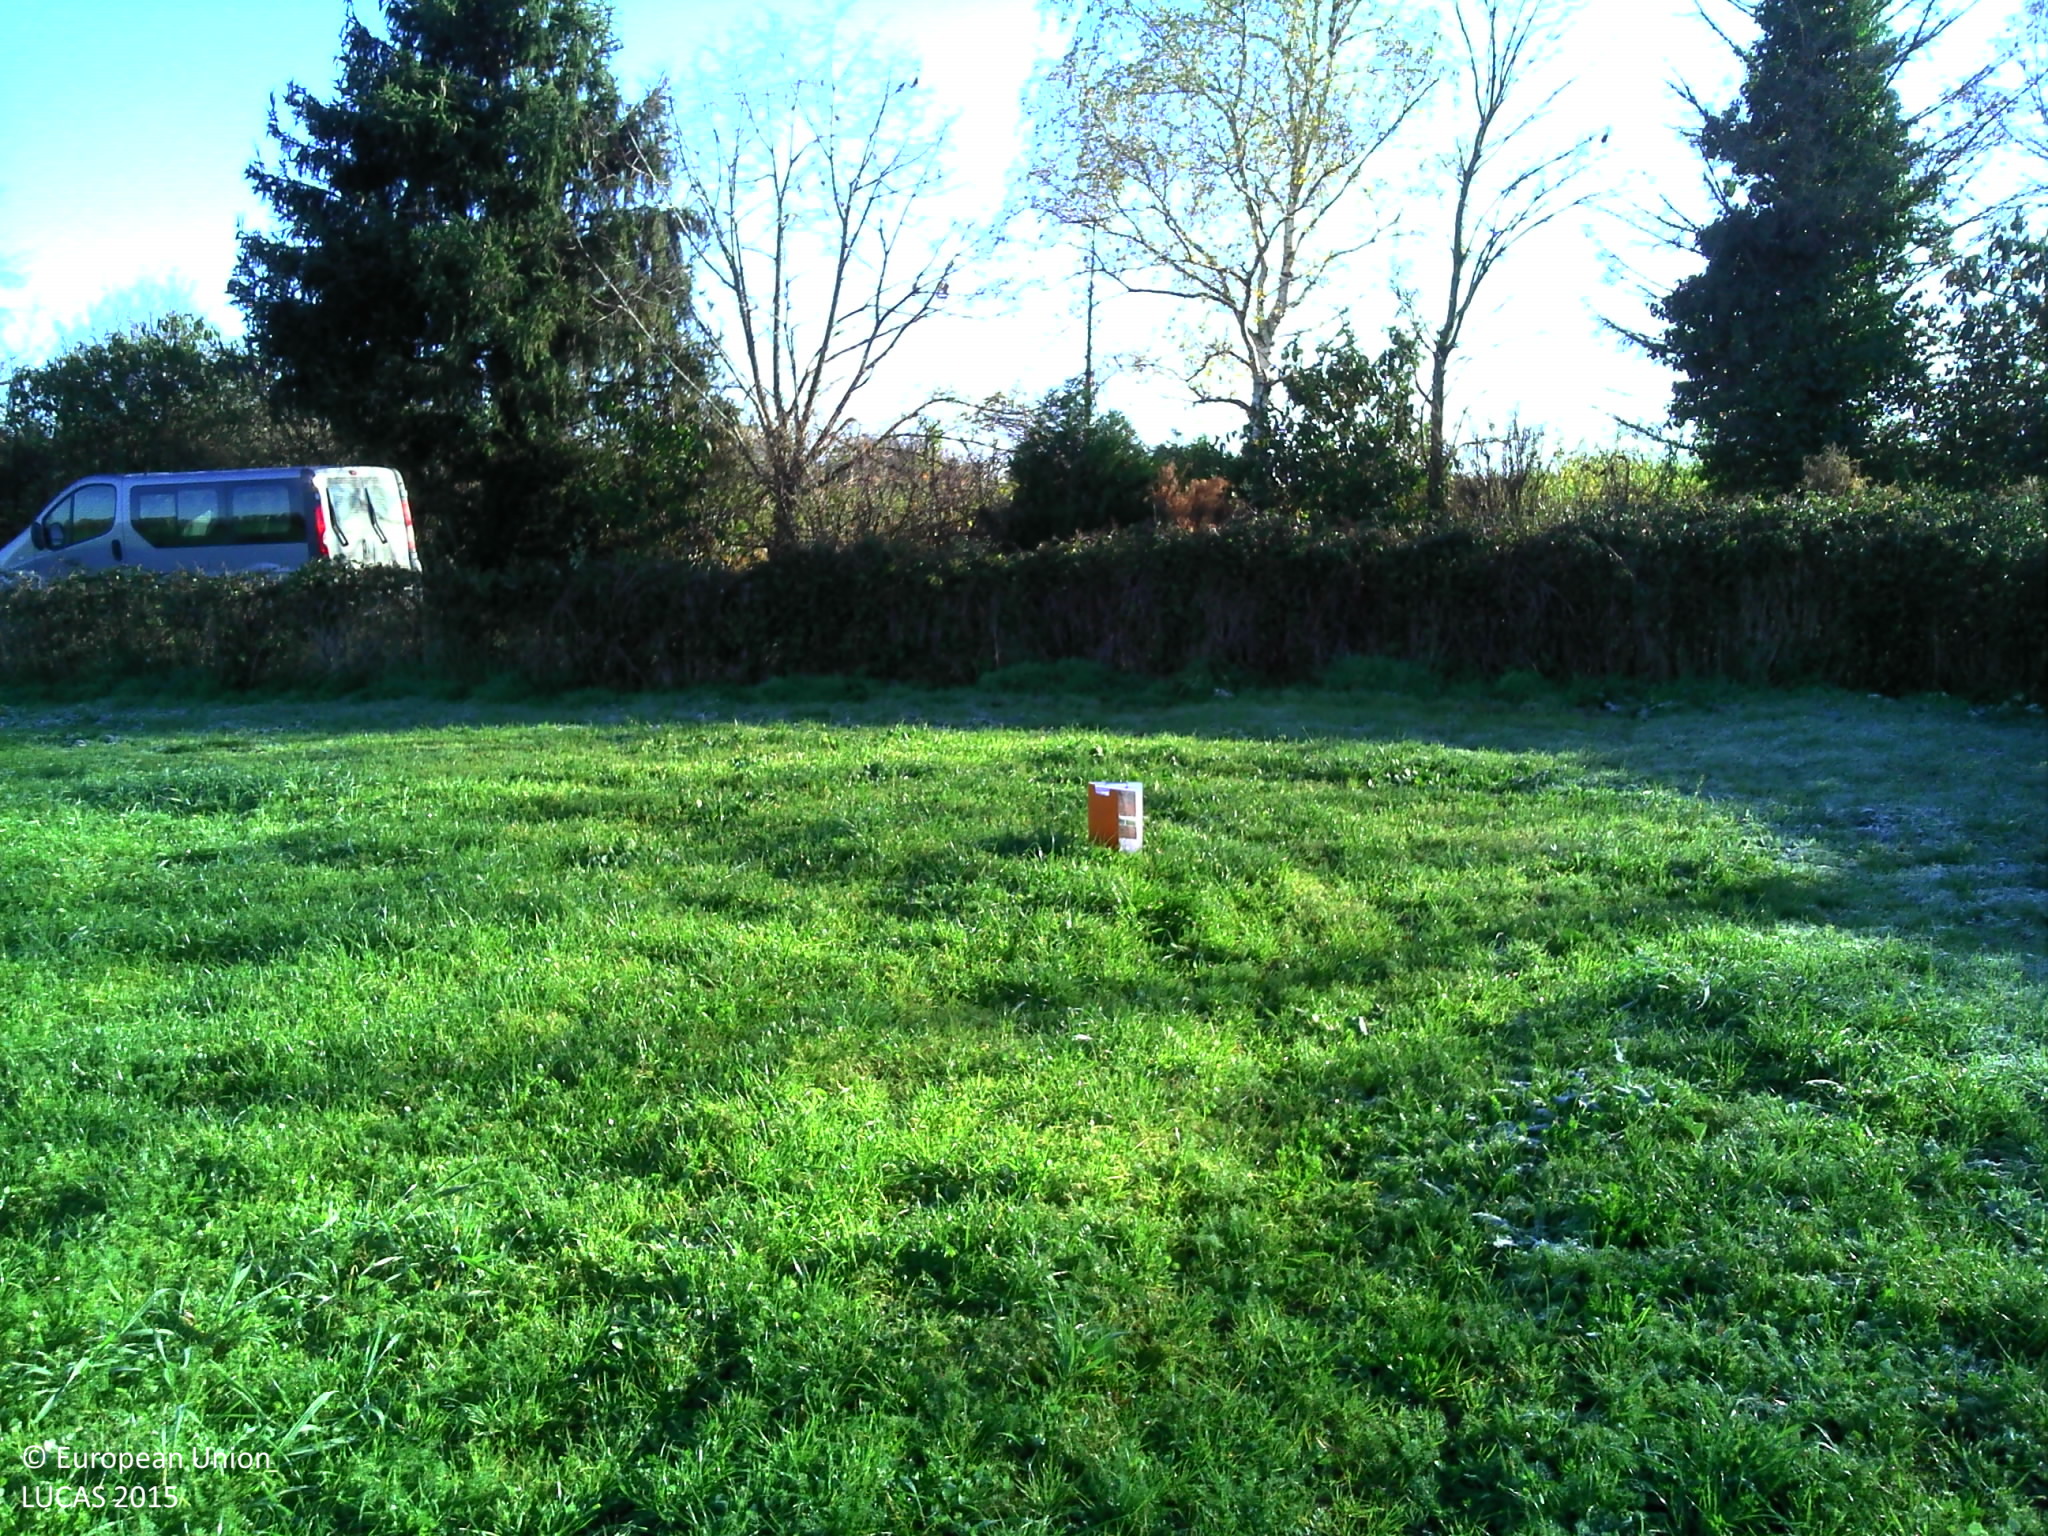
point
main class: Cropland
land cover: Temporary grasslands
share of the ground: > 75 %
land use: Agriculture (excluding fallow land and kitchen gardens)
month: May
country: FR
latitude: 46.3049
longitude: 2.7648
